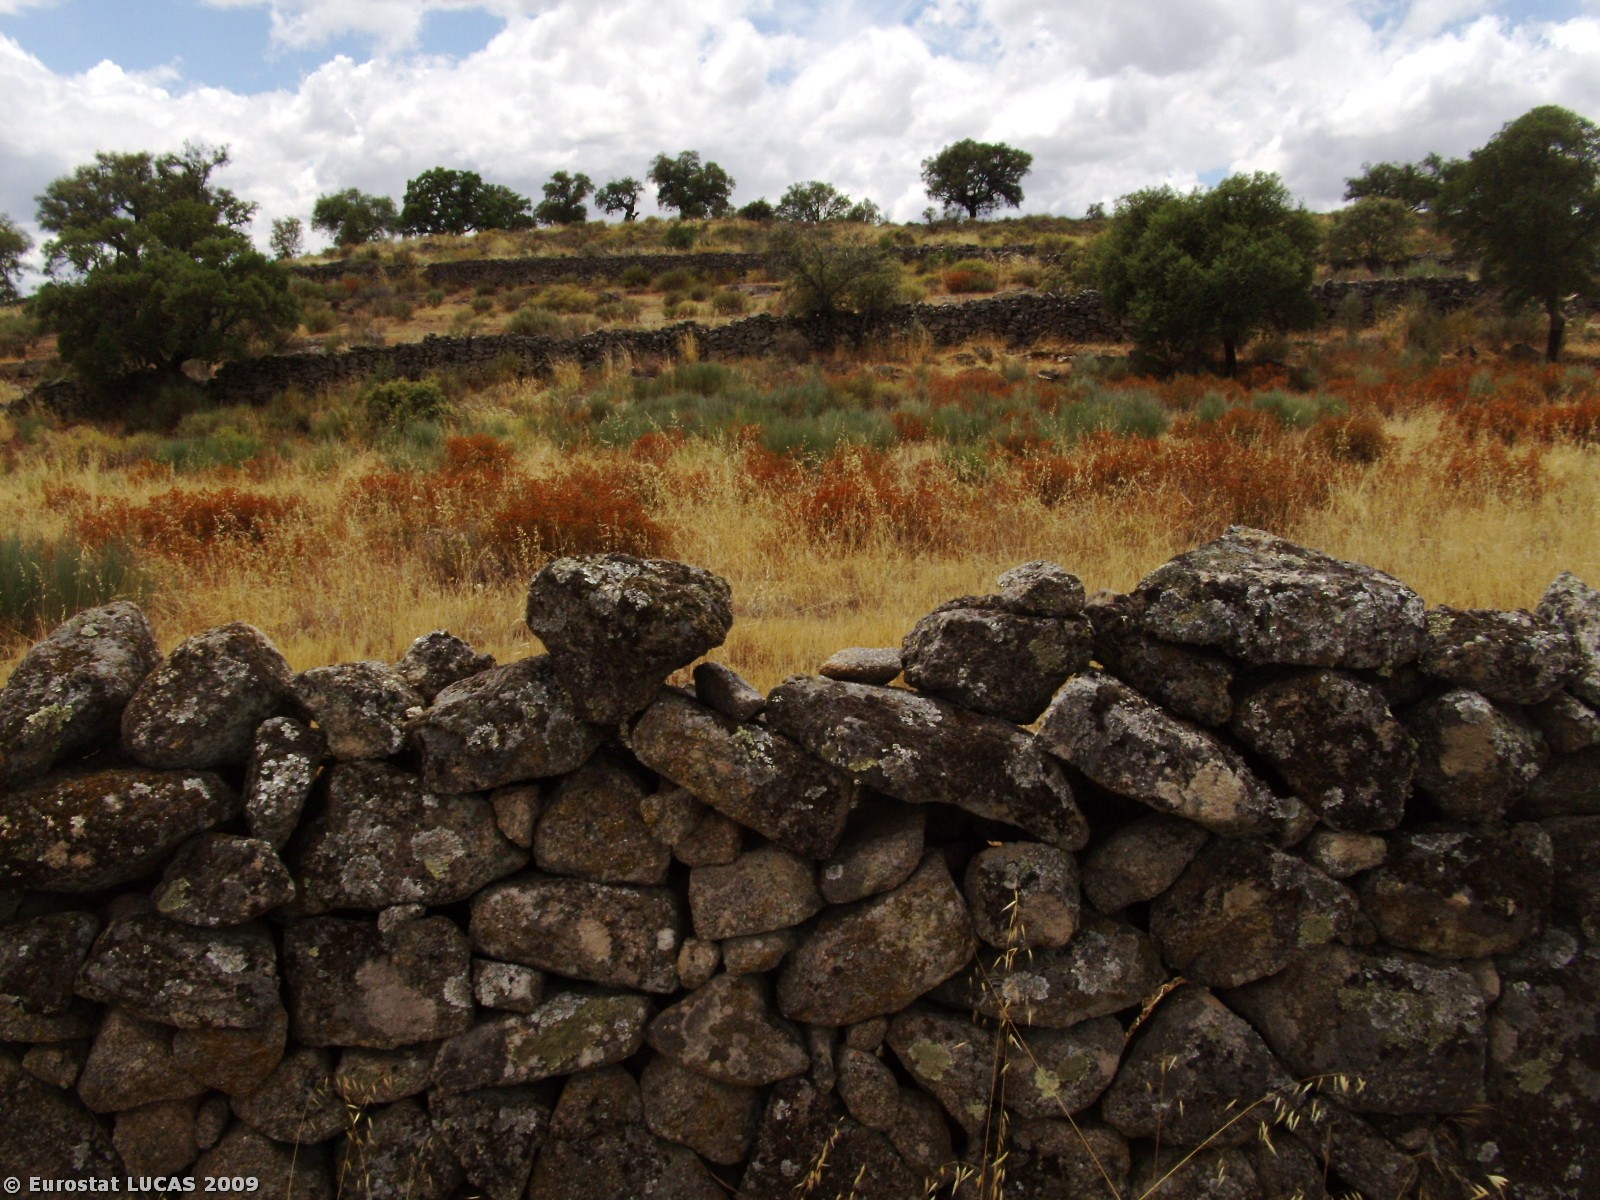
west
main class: Shrubland
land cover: Shrubland with sparse tree cover
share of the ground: > 75 %
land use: Unused
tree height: > 5 m
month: June
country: PT
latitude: 39.8750
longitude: -6.9111
